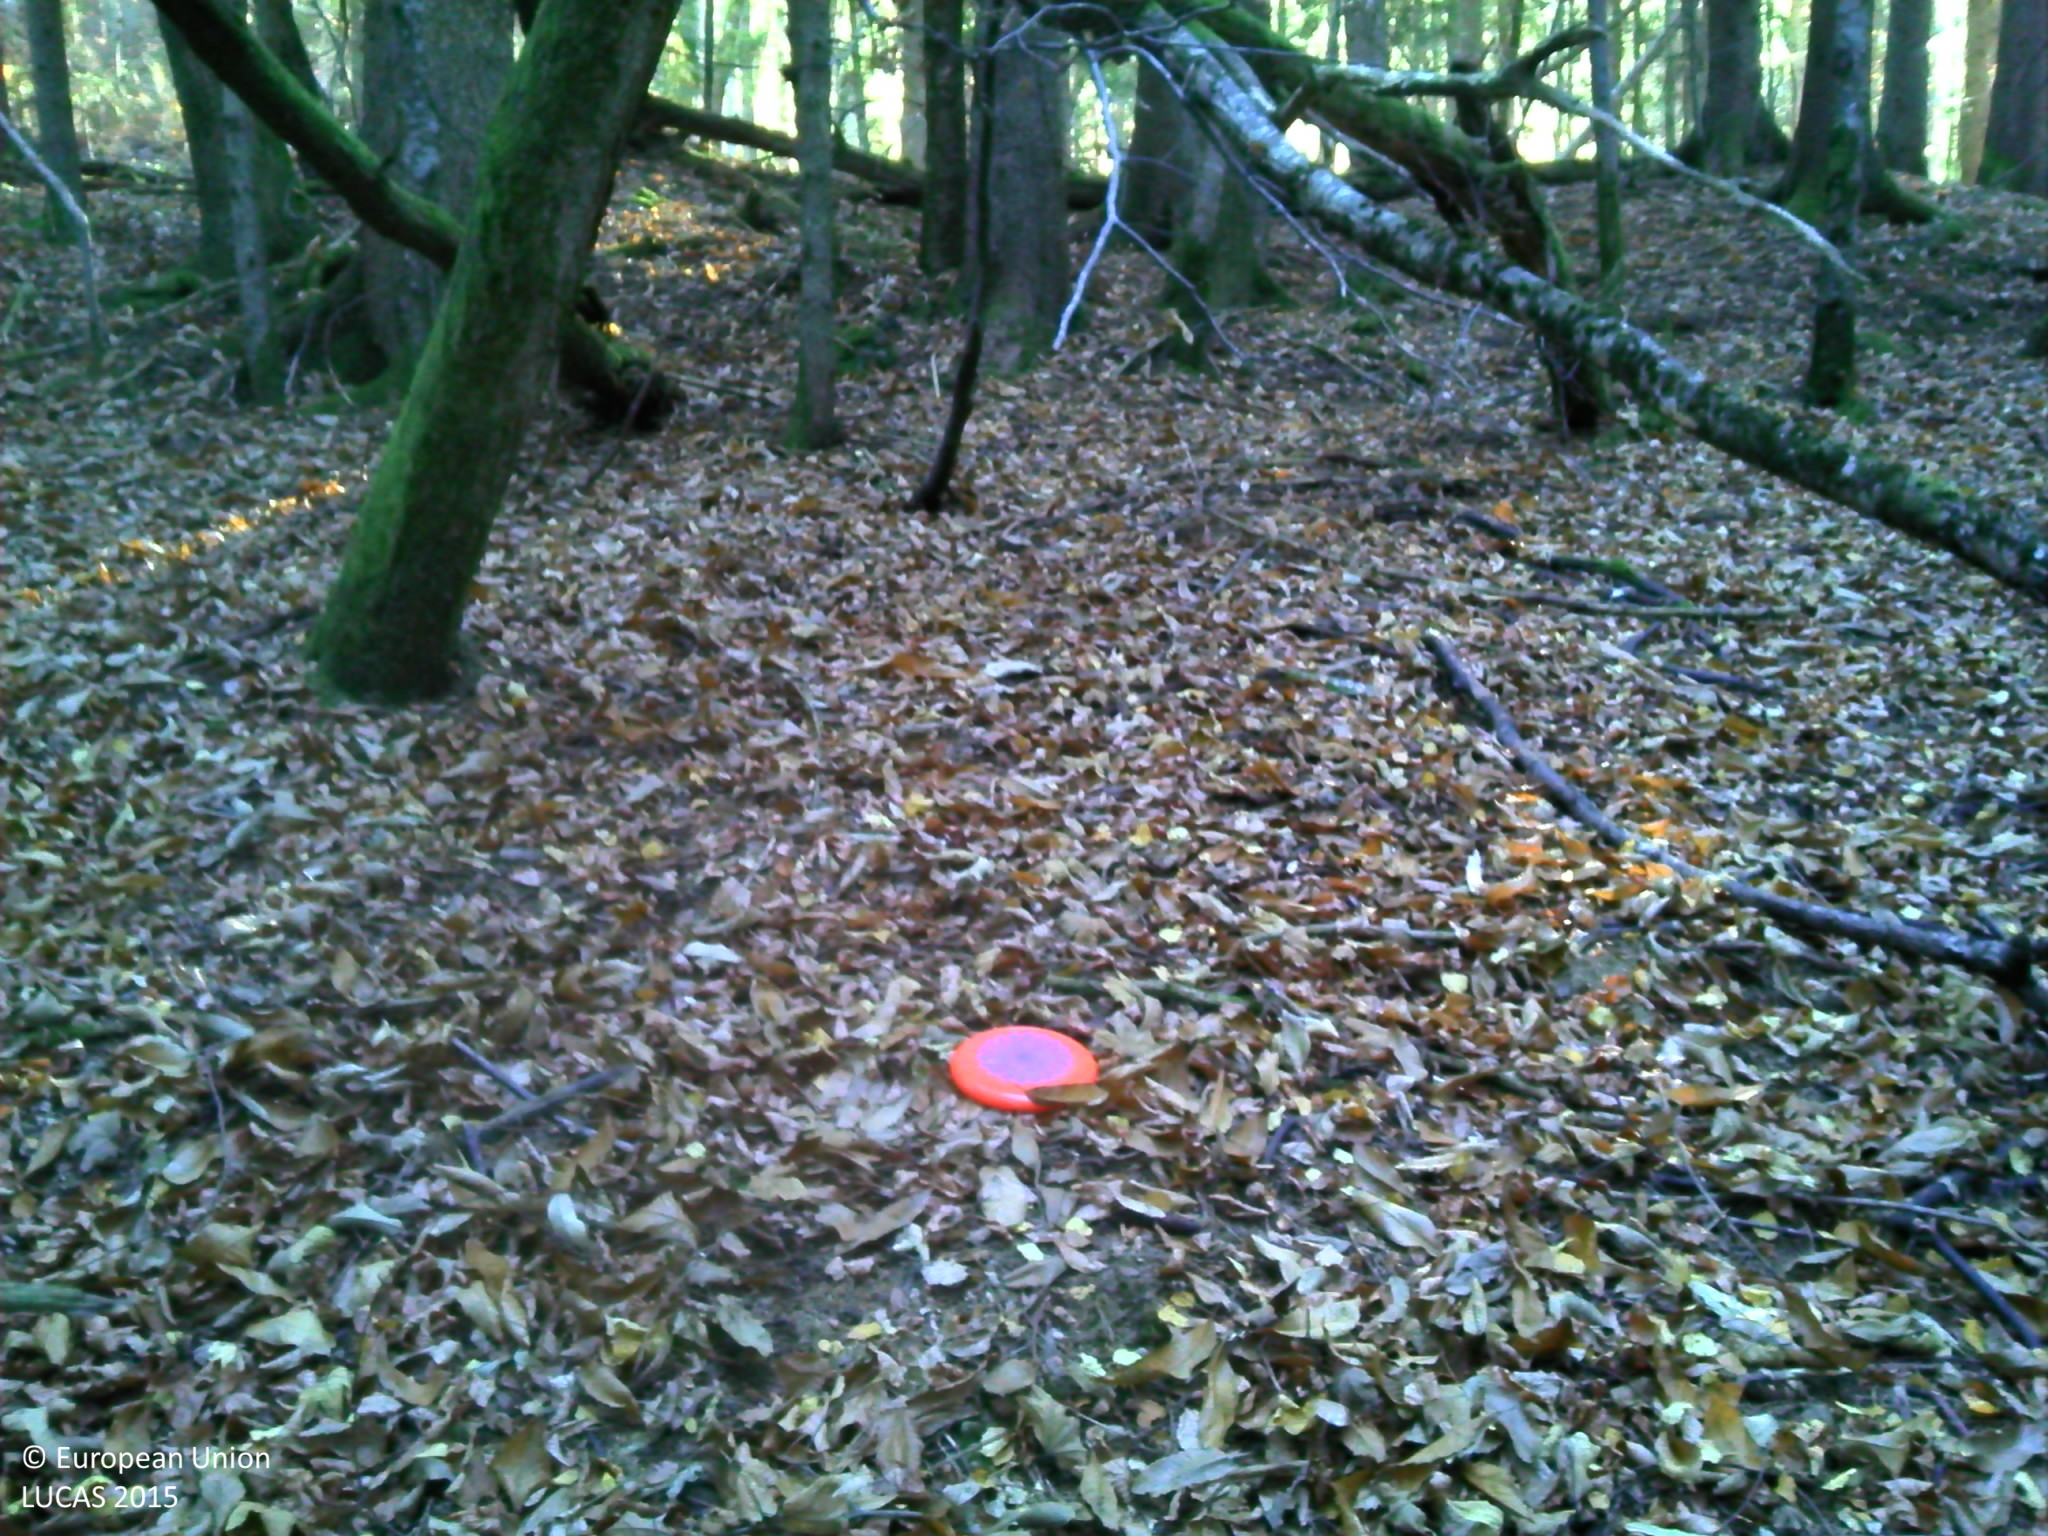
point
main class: Woodland
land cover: Spruce dominated coniferous woodland
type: hemiboreal forest and nemoral coniferous forest and mixed broadleaved-coniferous forest
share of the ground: > 75 %
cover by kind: coniferous forest trees 75 %, broadleaved forest trees 15 %, unconsolidated bare surface 10 %
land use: Forestry
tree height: > 5 m
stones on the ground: < 10 %
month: November
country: FR
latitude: 45.6037
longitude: 6.3504
